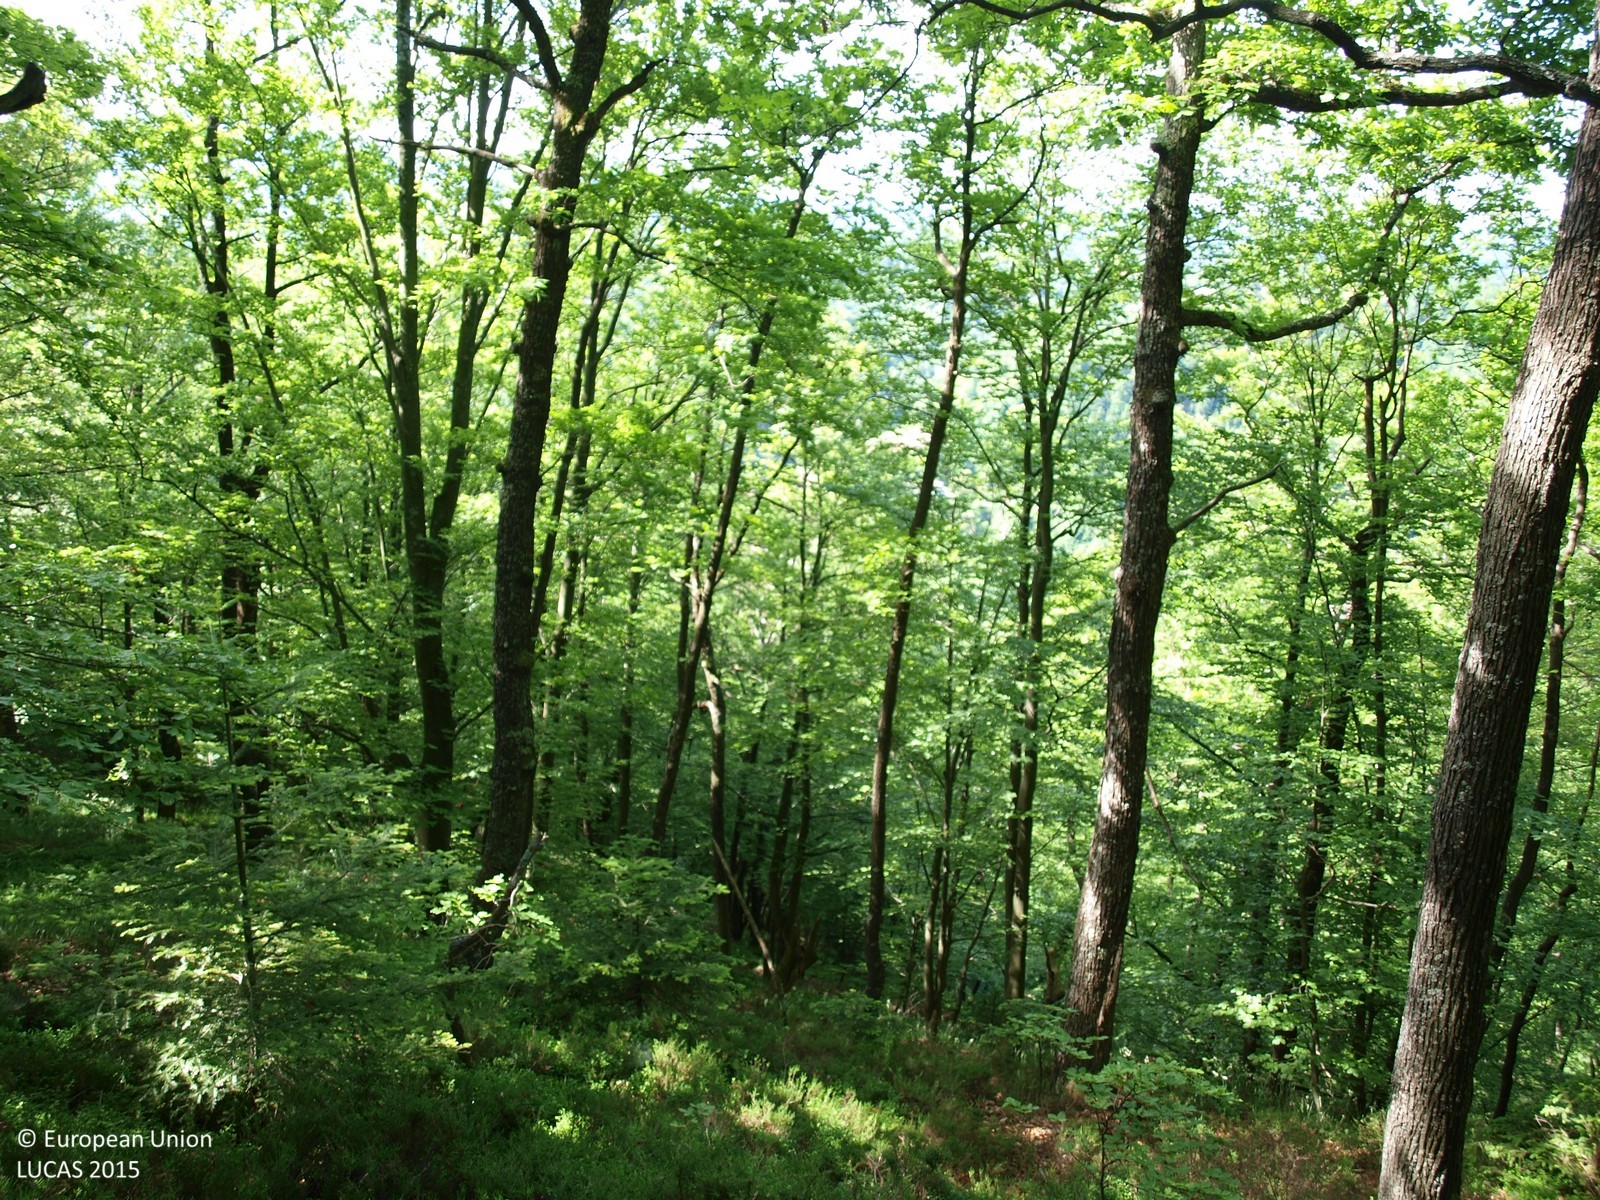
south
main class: Woodland
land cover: Broadleaved woodland
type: mesophytic deciduous forest
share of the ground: > 75 %
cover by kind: broadleaved forest trees 100 %
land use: Forestry
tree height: > 5 m
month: May
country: HR
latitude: 46.2605
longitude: 15.9018
